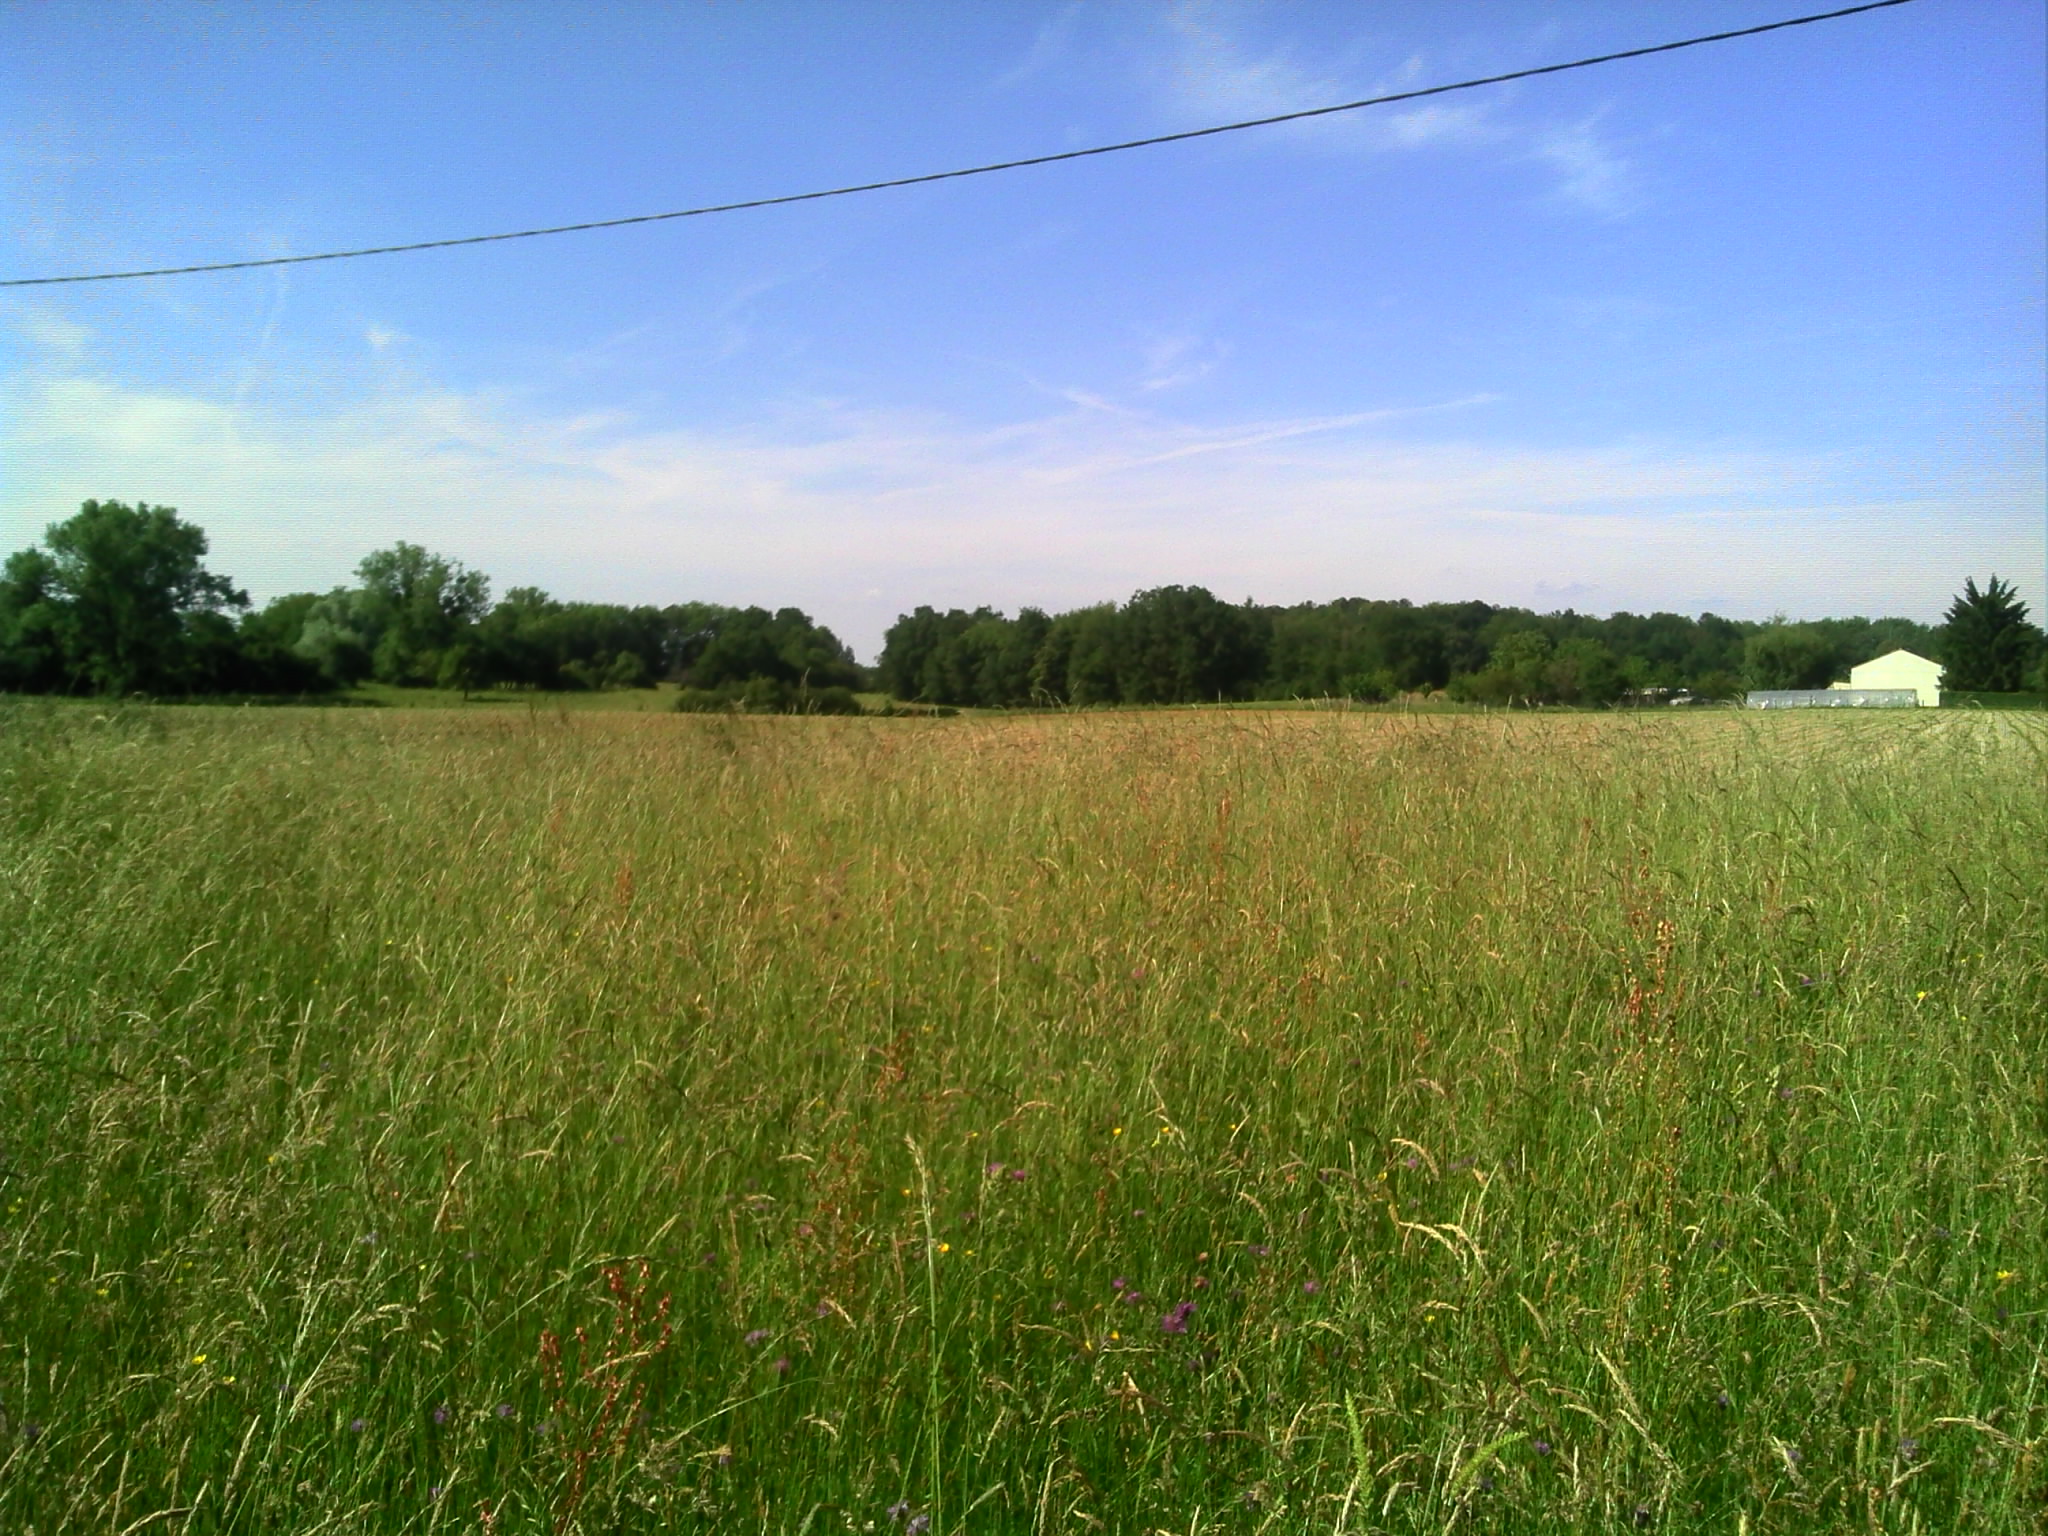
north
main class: Grassland
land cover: Grassland without tree/shrub cover
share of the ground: > 75 %
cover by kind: herbaceous plants 100 %
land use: Agriculture (excluding fallow land and kitchen gardens)
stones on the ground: < 10 %
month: May
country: FR
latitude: 46.6013
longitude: 5.1327
